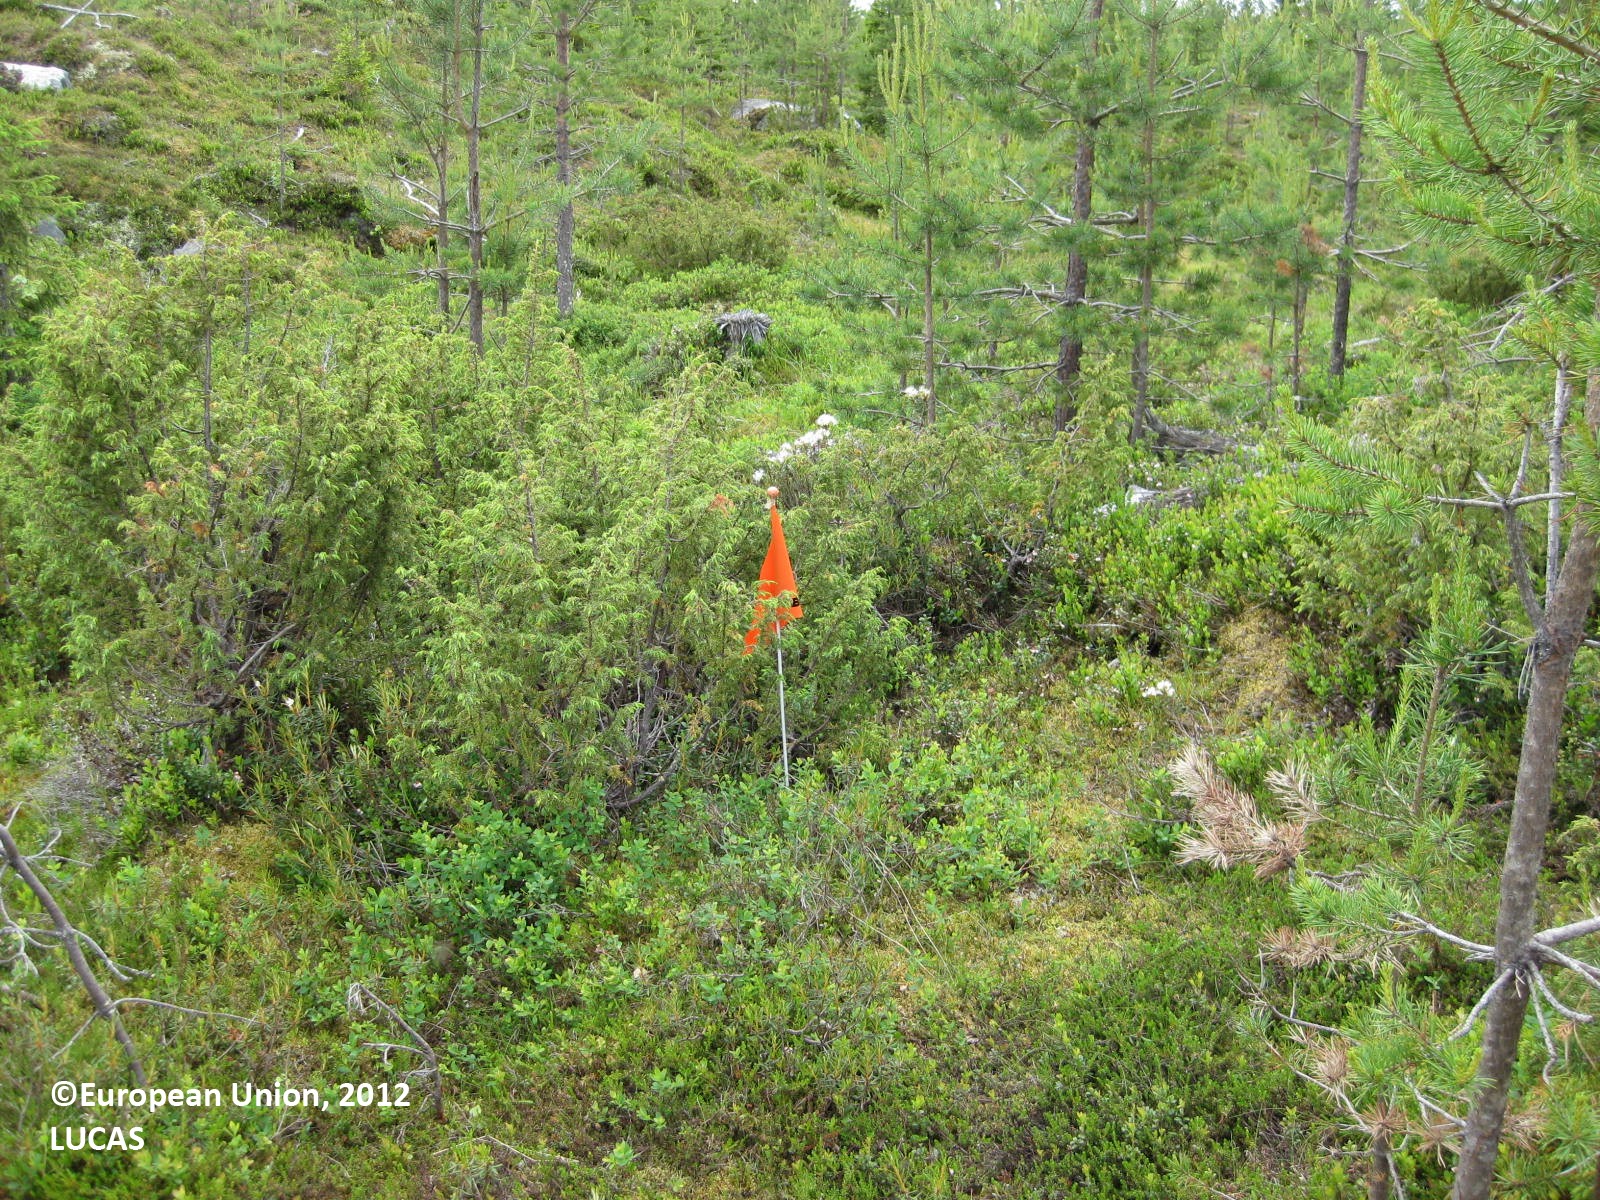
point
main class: Woodland
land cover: Pine dominated coniferous woodland
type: boreal forest
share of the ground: 50 - 75 %
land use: Forestry
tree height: > 5 m
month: July
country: FI
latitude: 65.4805
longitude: 29.3027
